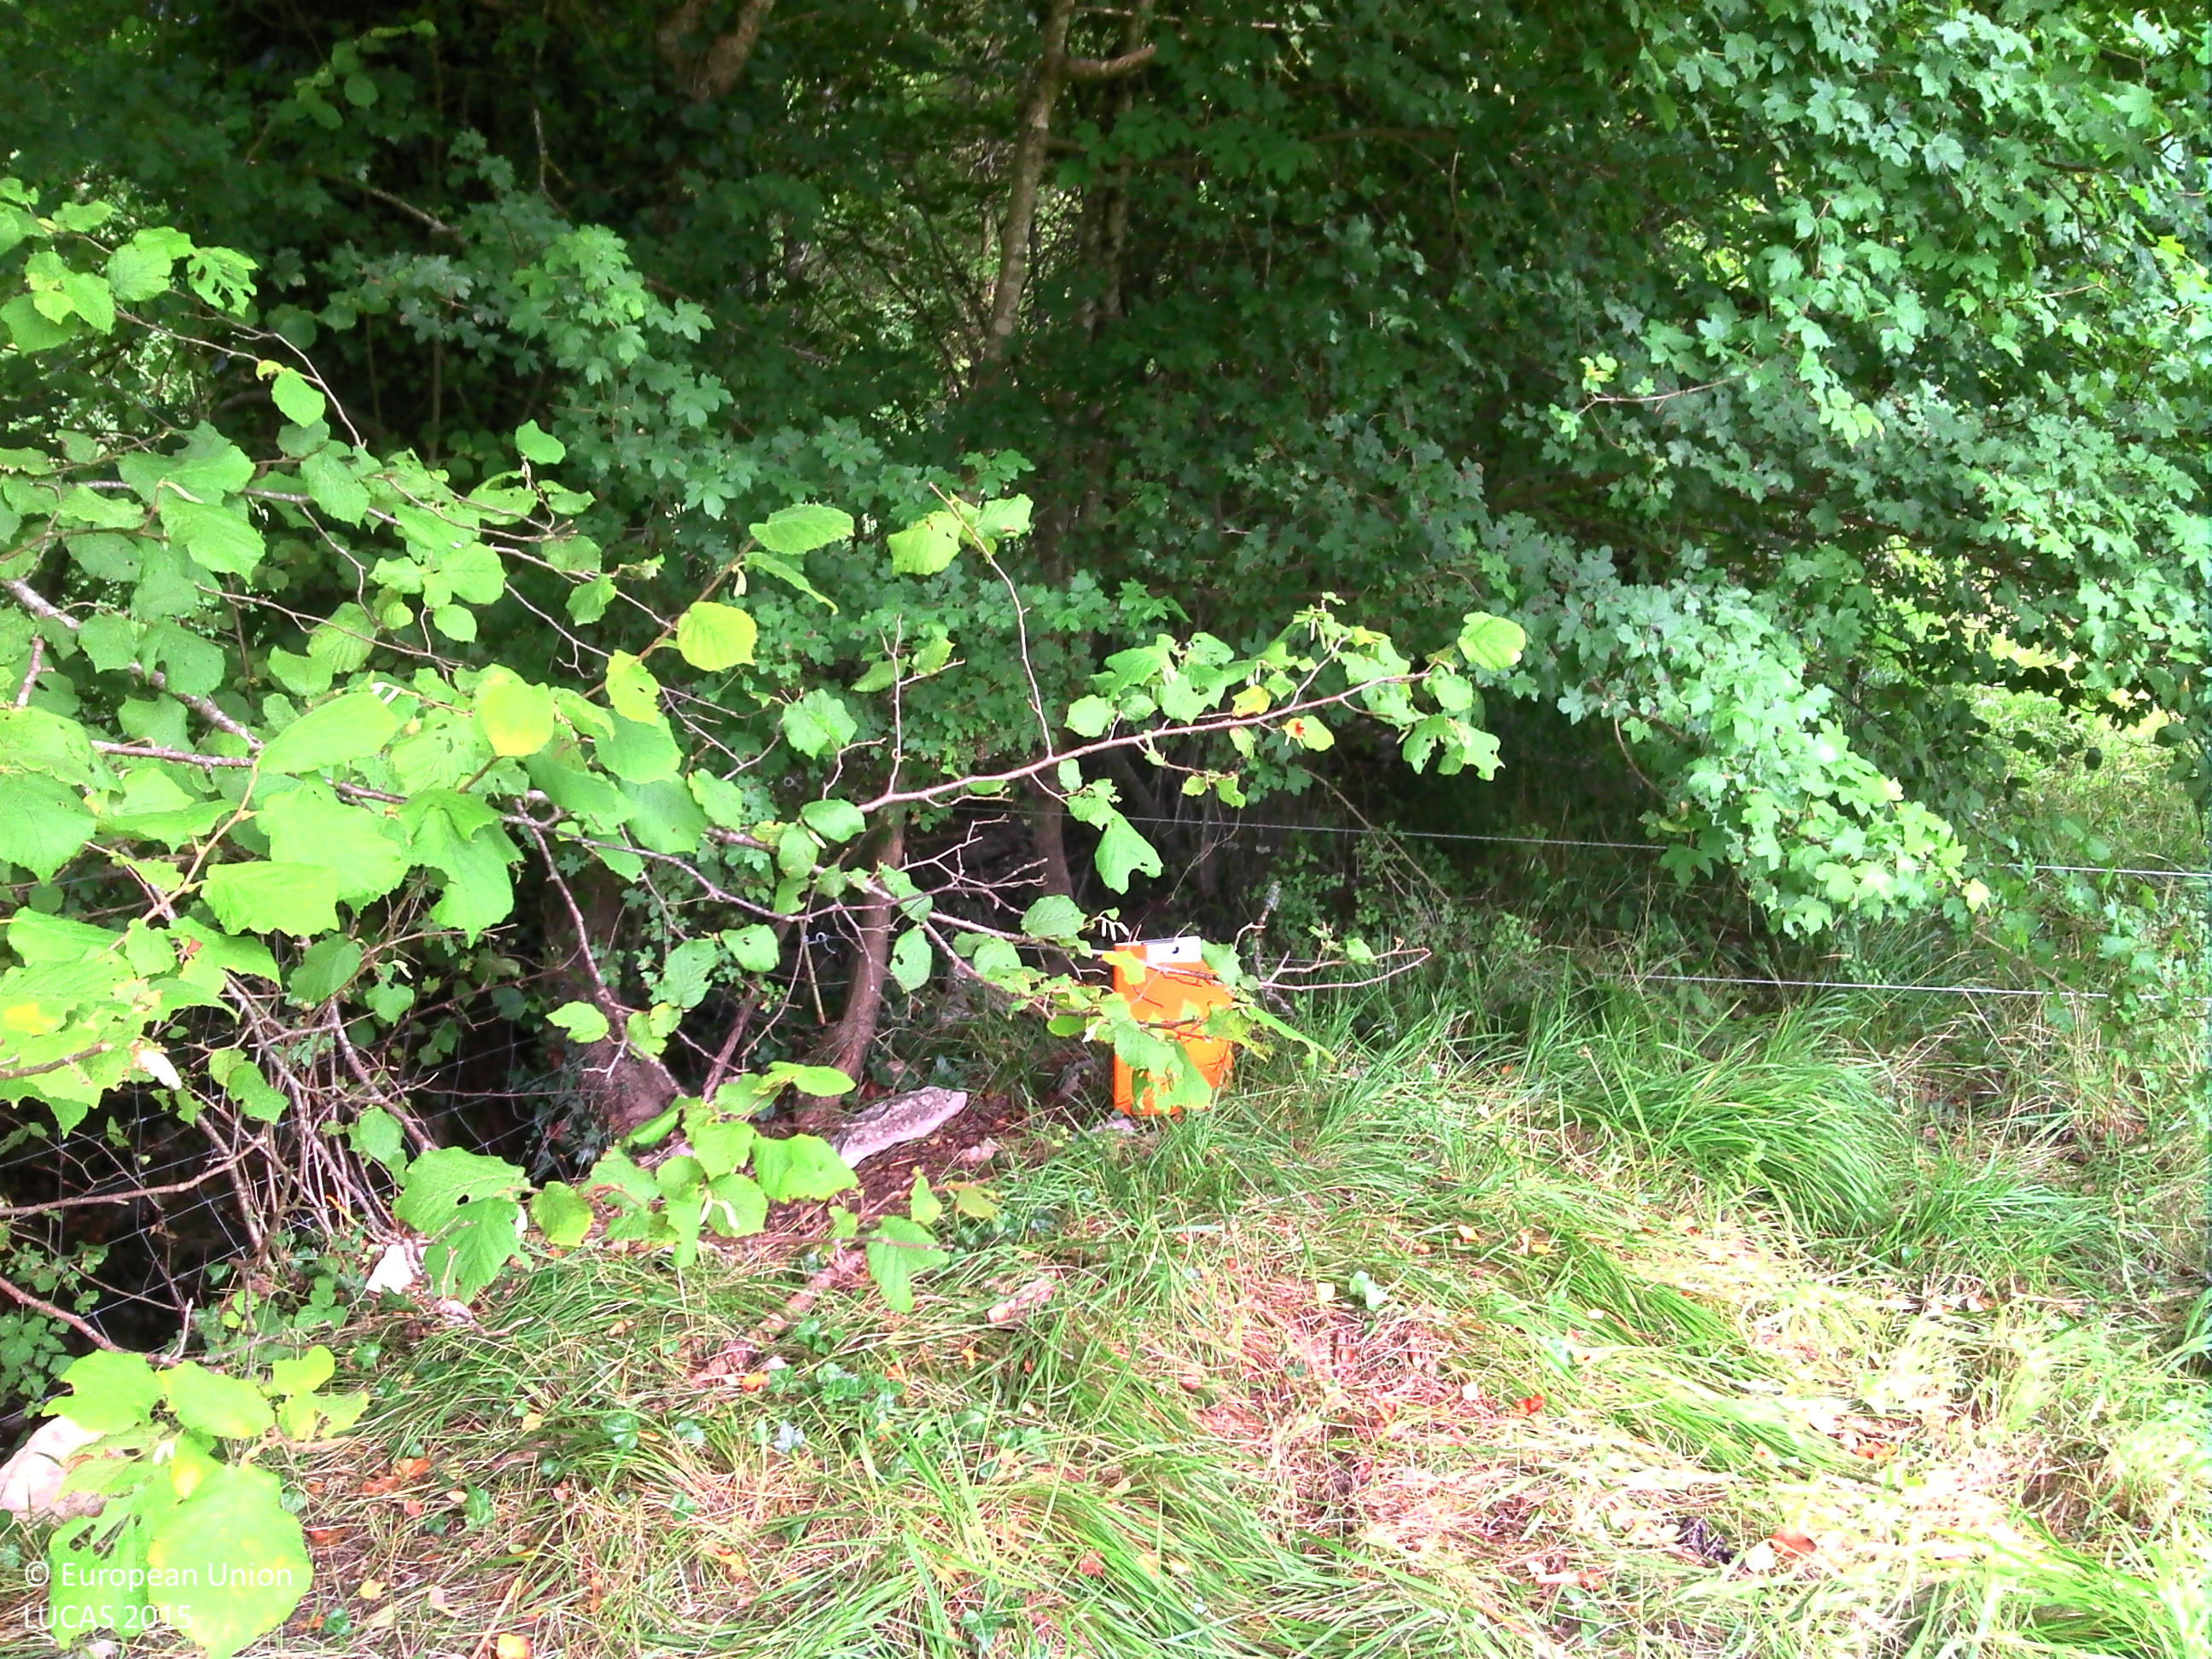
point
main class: Woodland
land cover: Broadleaved woodland
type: non-riverine alder, birch or aspen forest
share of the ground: > 75 %
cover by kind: broadleaved forest trees 60 %, shrubs 20 %, herbaceous plants 20 %
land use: Semi-natural and natural areas not in use
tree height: > 5 m
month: September
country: FR
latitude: 44.6527
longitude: 1.4857
